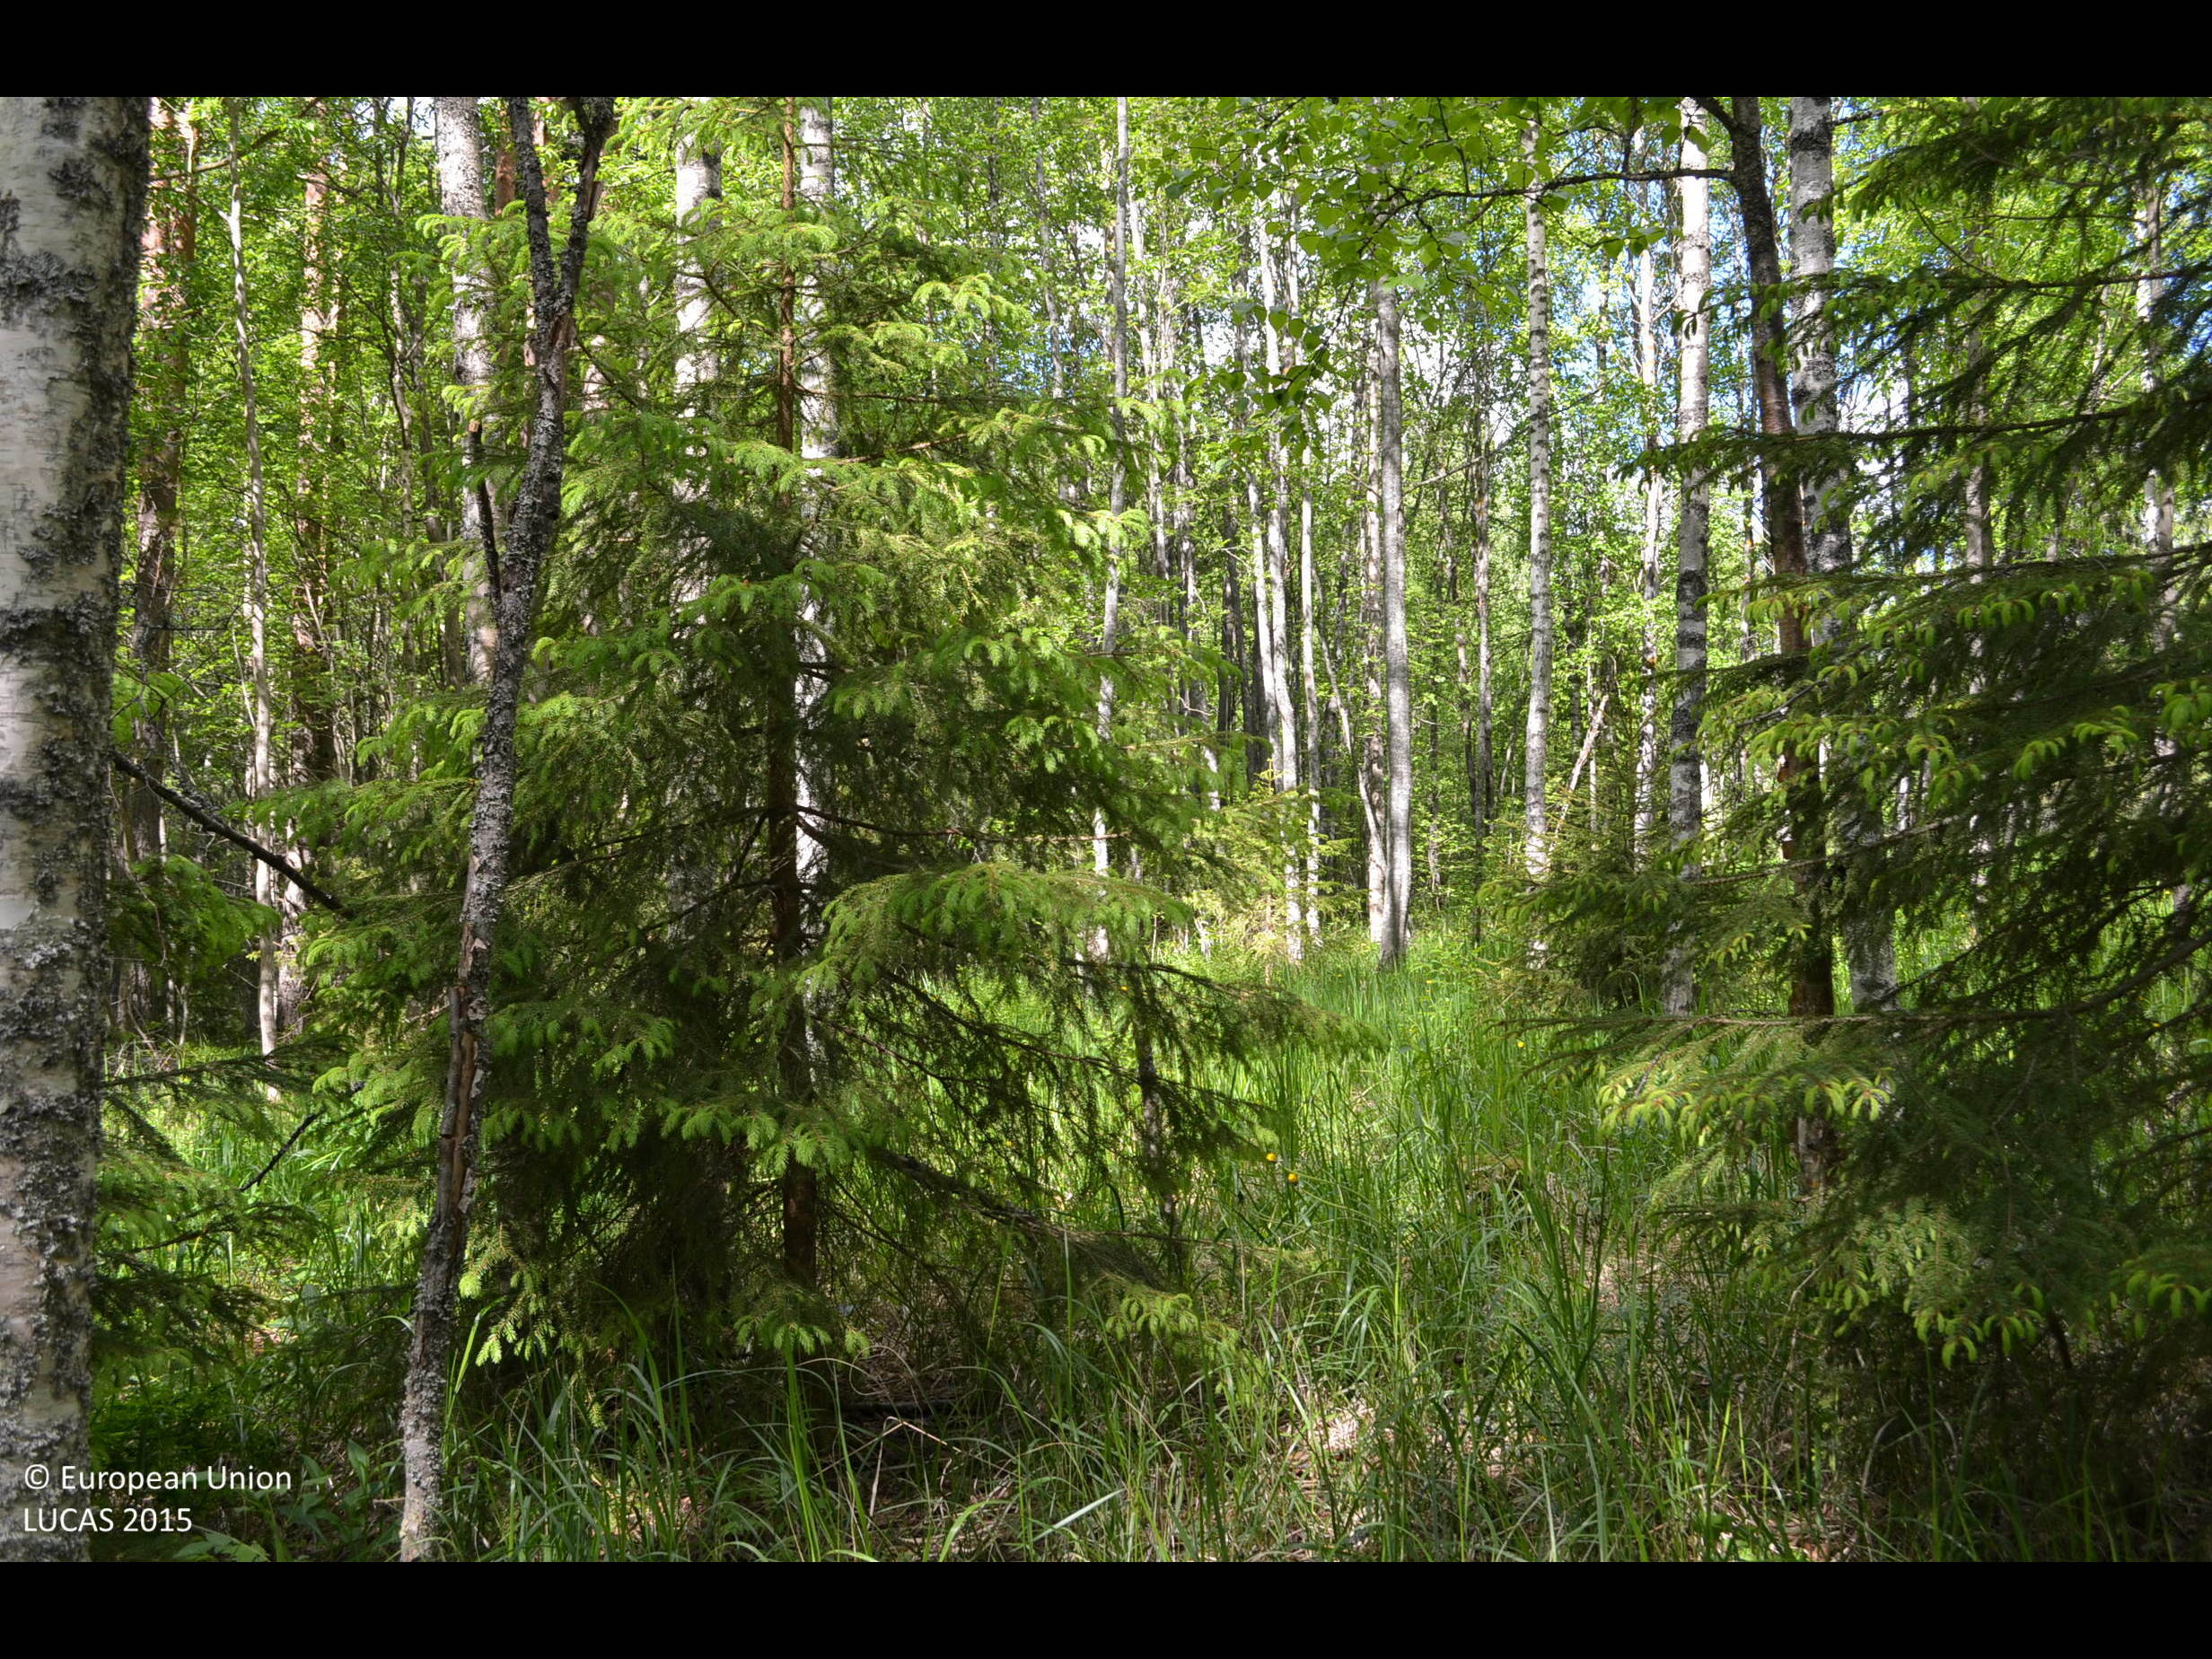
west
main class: Woodland
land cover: Spruce dominated mixed woodland
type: boreal forest
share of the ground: > 75 %
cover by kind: coniferous forest trees 40 %, broadleaved forest trees 40 %, herbaceous plants 20 %
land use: Forestry
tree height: > 5 m
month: June
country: FI
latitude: 61.9622
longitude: 23.5205
